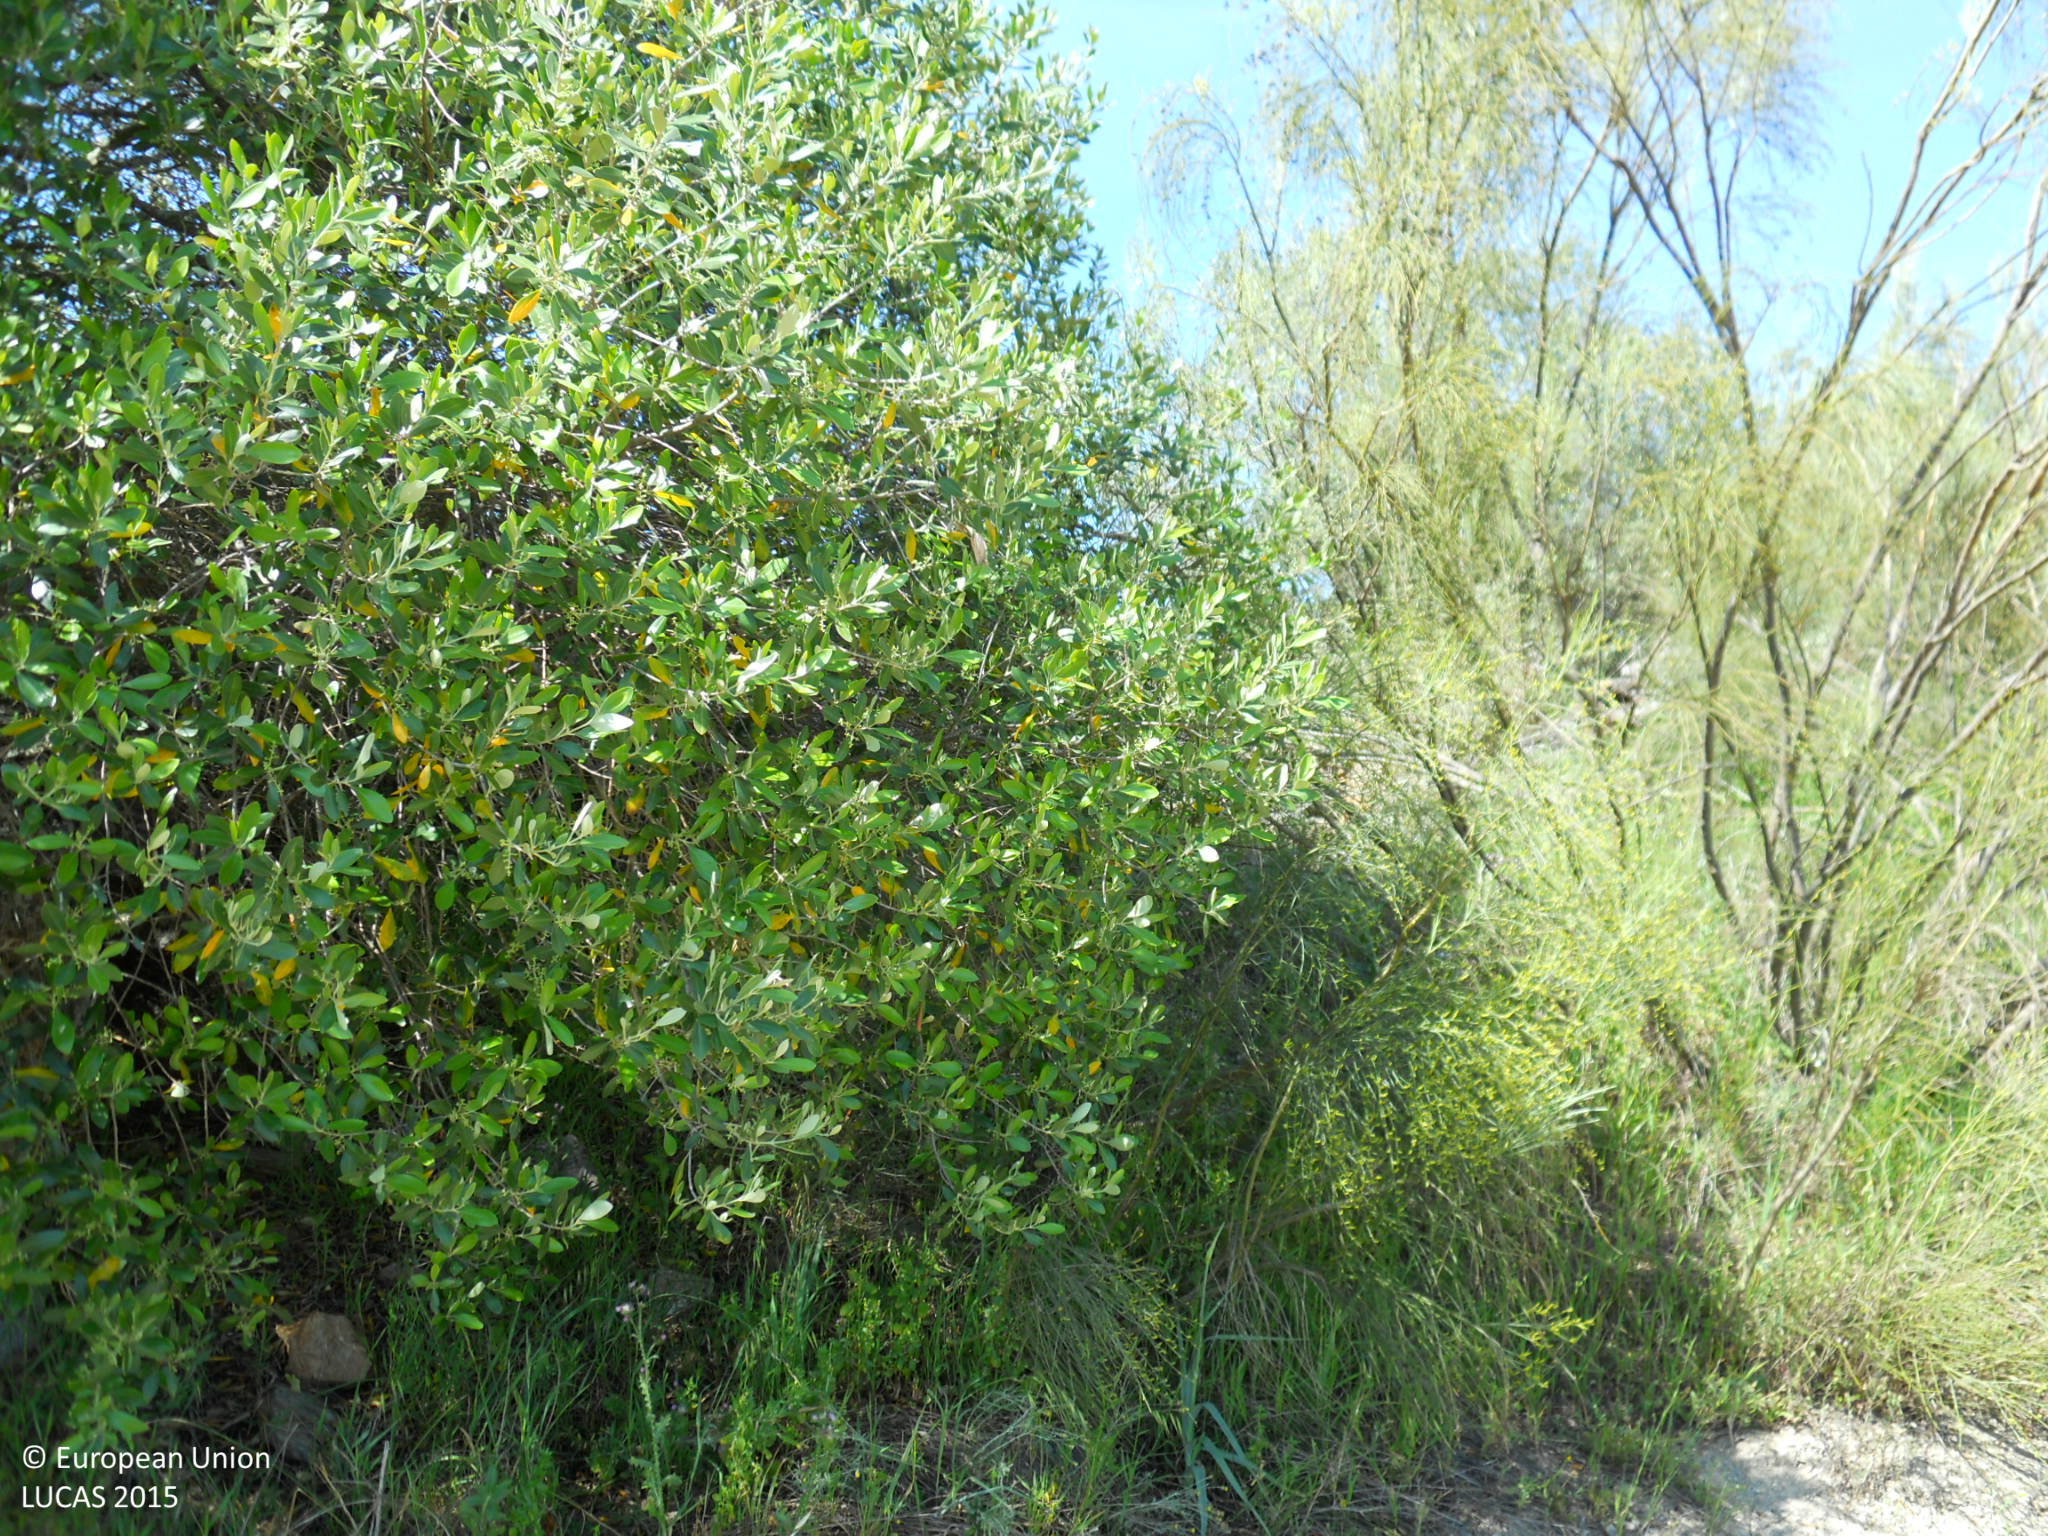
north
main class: Cropland
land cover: Mixed cereals for fodder
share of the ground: > 75 %
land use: Agriculture (excluding fallow land and kitchen gardens)
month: April
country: ES
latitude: 39.1328
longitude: -6.8341
